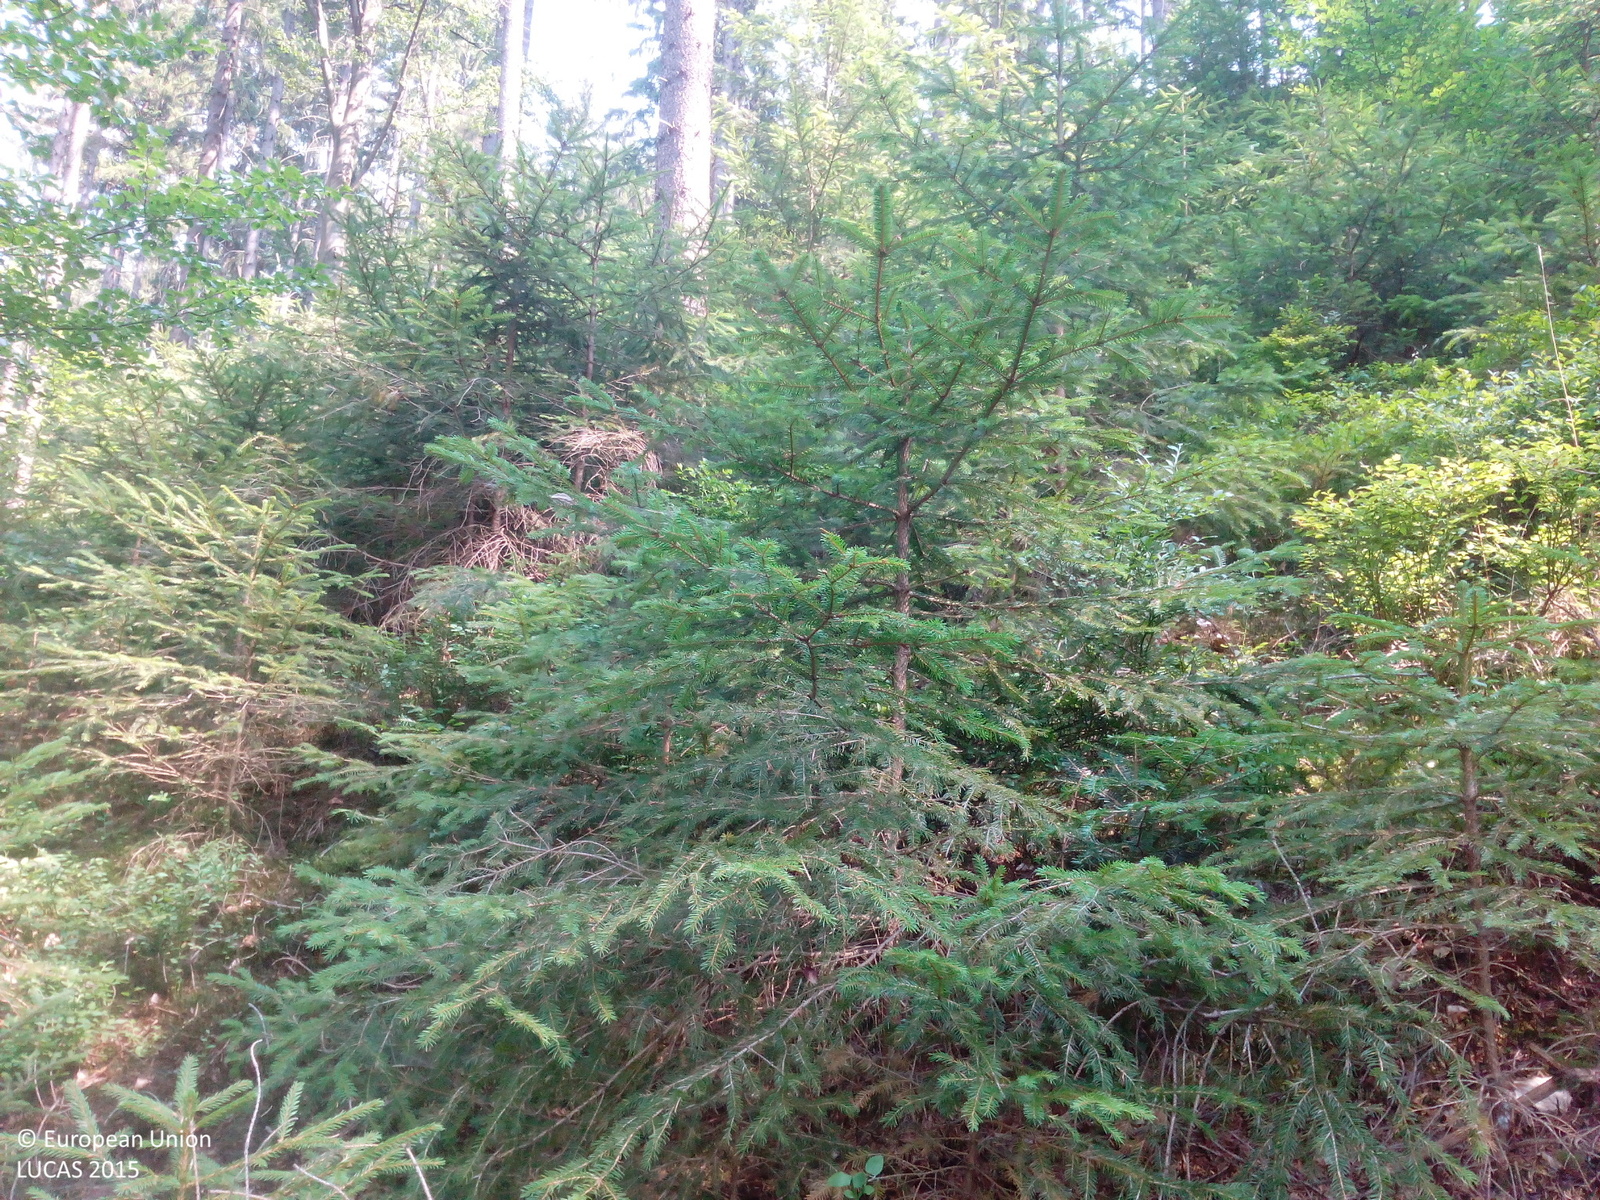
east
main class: Woodland
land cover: Spruce dominated coniferous woodland
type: hemiboreal forest and nemoral coniferous forest and mixed broadleaved-coniferous forest
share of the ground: > 75 %
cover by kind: coniferous forest trees 90 %, shrubs 10 %
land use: Forestry
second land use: Amenities, museums, leisure
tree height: > 5 m
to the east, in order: Spruce dominated coniferous woodland; Tracks; Spruce dominated coniferous woodland; Tracks; Spruce dominated coniferous woodland; Tracks; Spruce dominated coniferous woodland
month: August
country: DE
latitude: 50.2991
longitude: 11.5860
